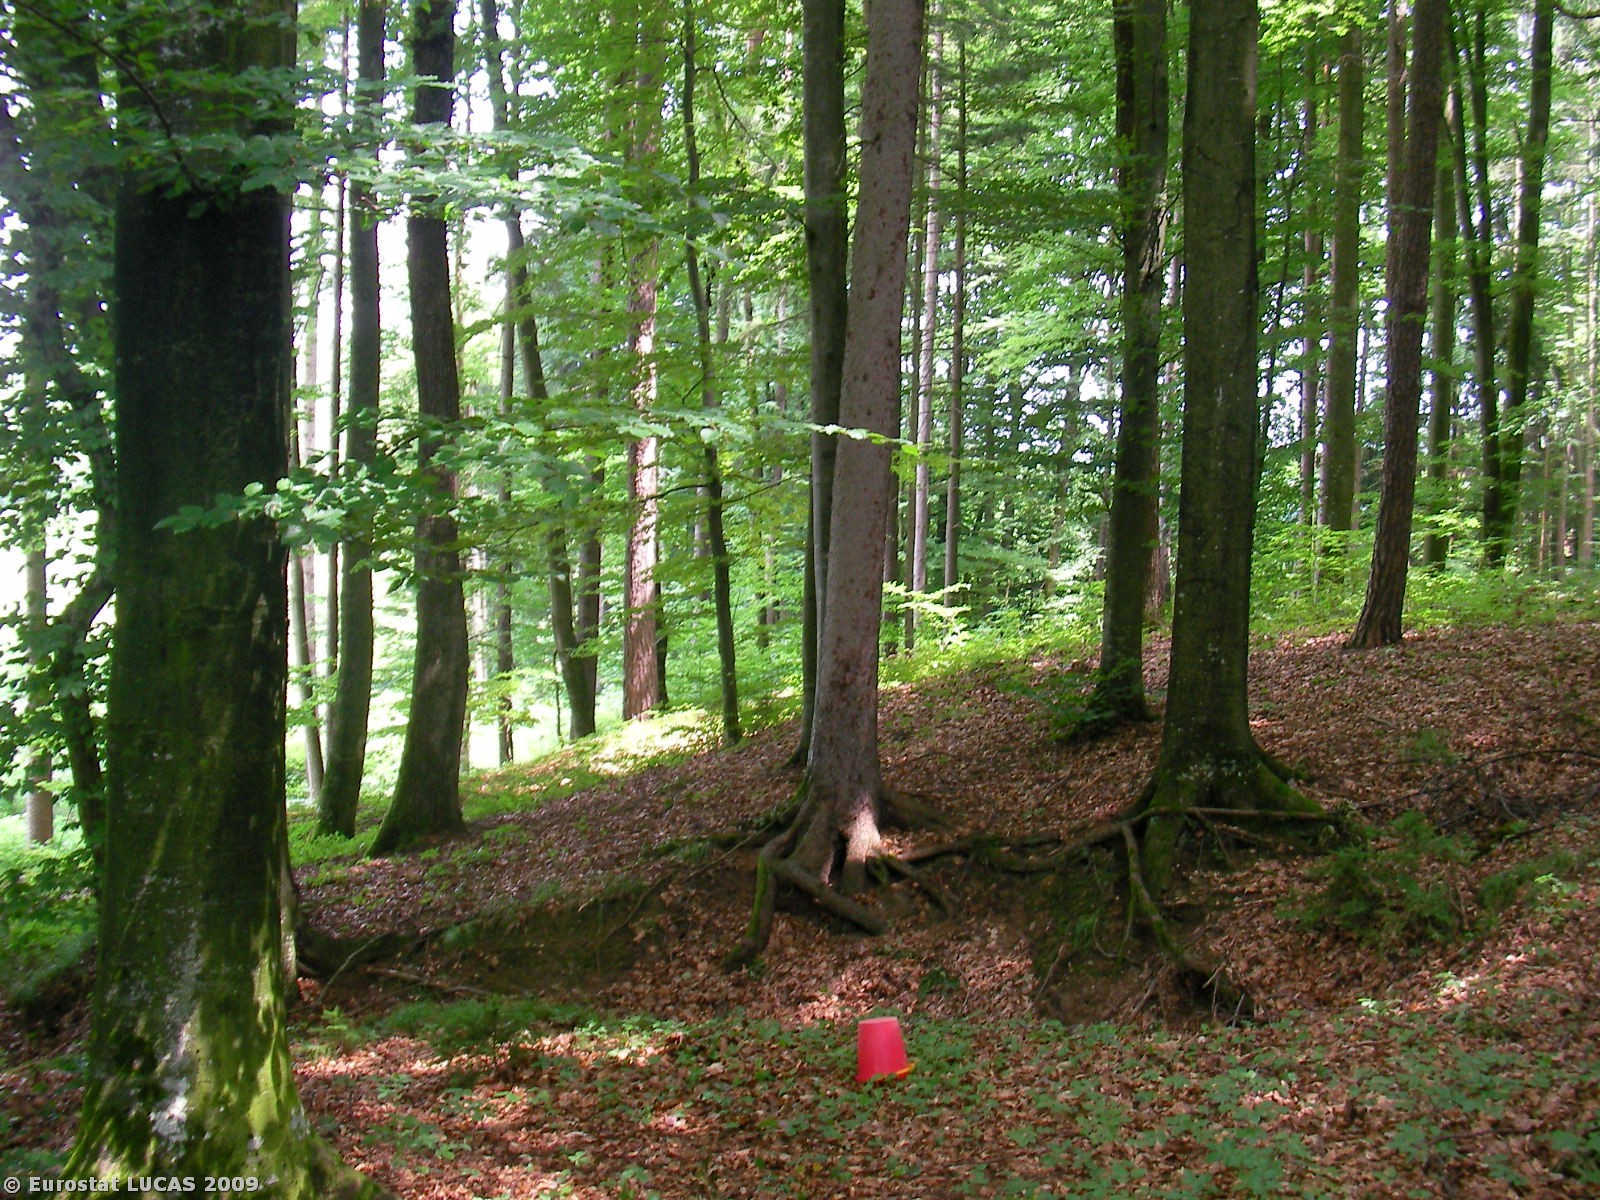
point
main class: Woodland
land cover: Mixed woodland
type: hemiboreal forest and nemoral coniferous forest and mixed broadleaved-coniferous forest
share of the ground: > 75 %
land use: Forestry
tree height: > 5 m
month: June
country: AT
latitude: 47.0283
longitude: 15.7241
